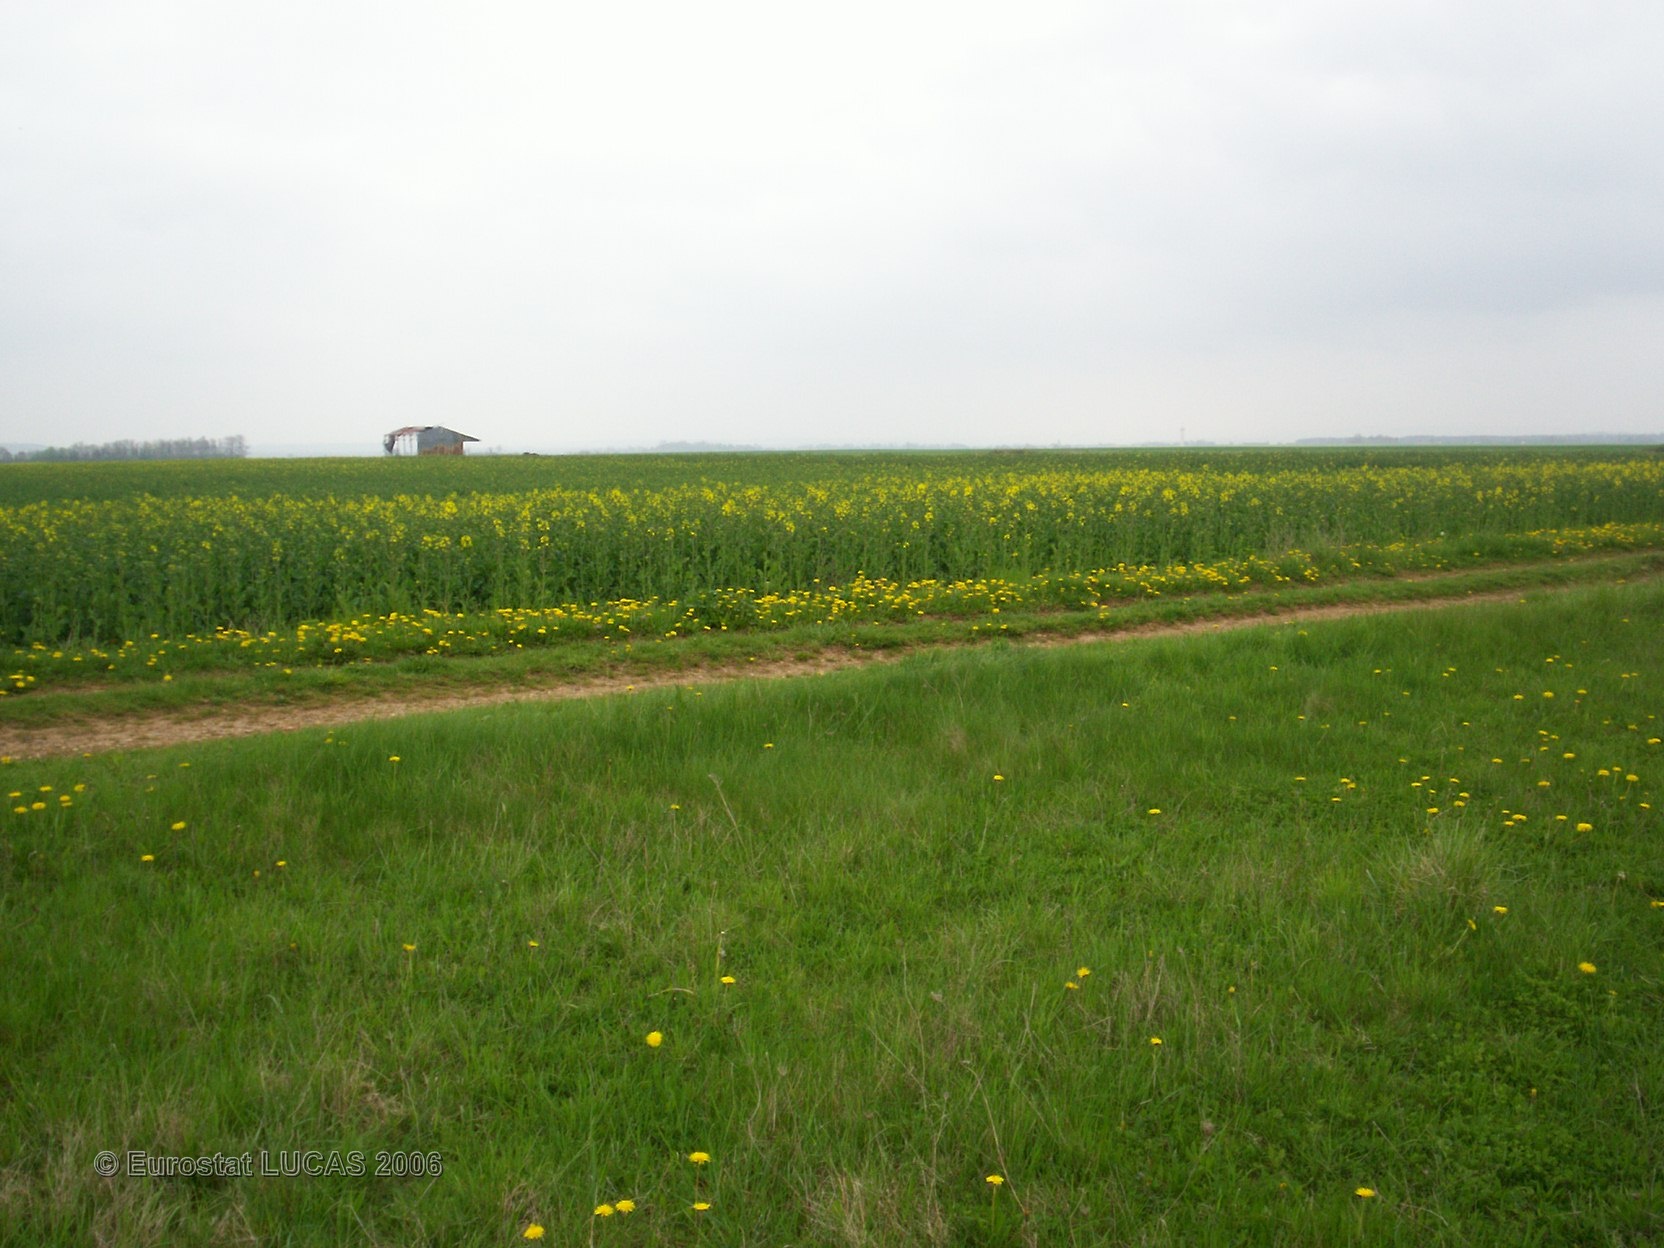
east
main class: Grassland
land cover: Grassland without tree/shrub cover
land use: Agriculture (excluding fallow land and kitchen gardens)
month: April
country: FR
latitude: 49.0573
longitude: -0.1729
